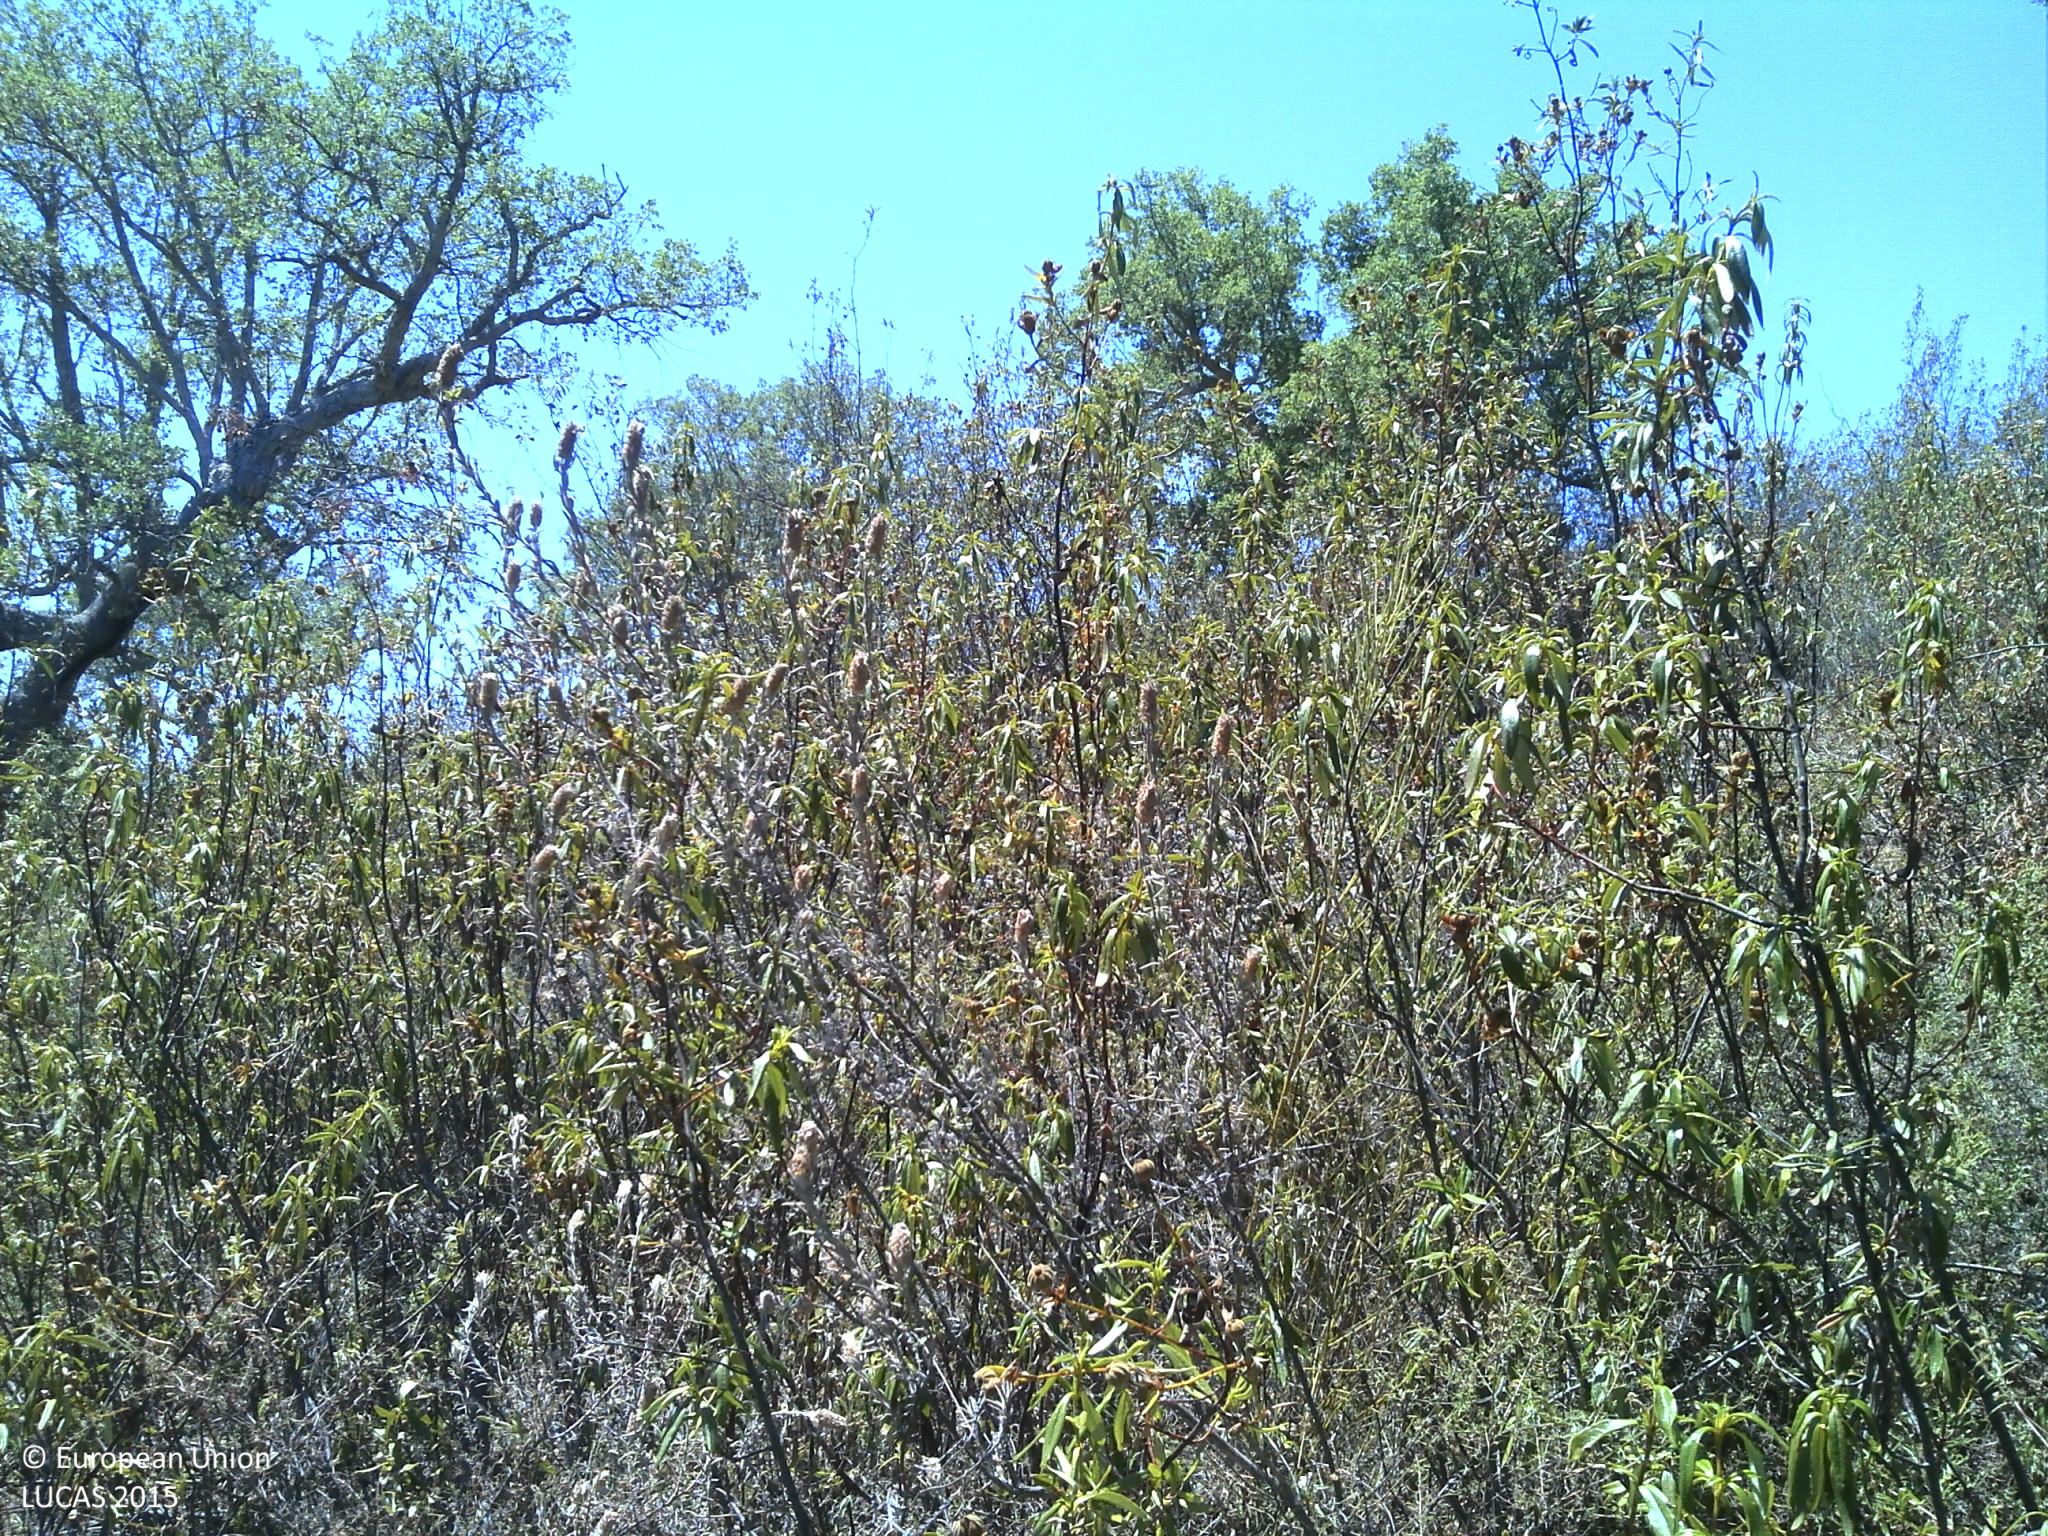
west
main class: Woodland
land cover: Broadleaved woodland
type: broadleaved evergreen forest
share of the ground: 25 - 50 %
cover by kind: shrubs 75 %, broadleaved forest trees 25 %
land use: Forestry
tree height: > 5 m
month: July
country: PT
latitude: 39.1469
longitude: -7.1690
